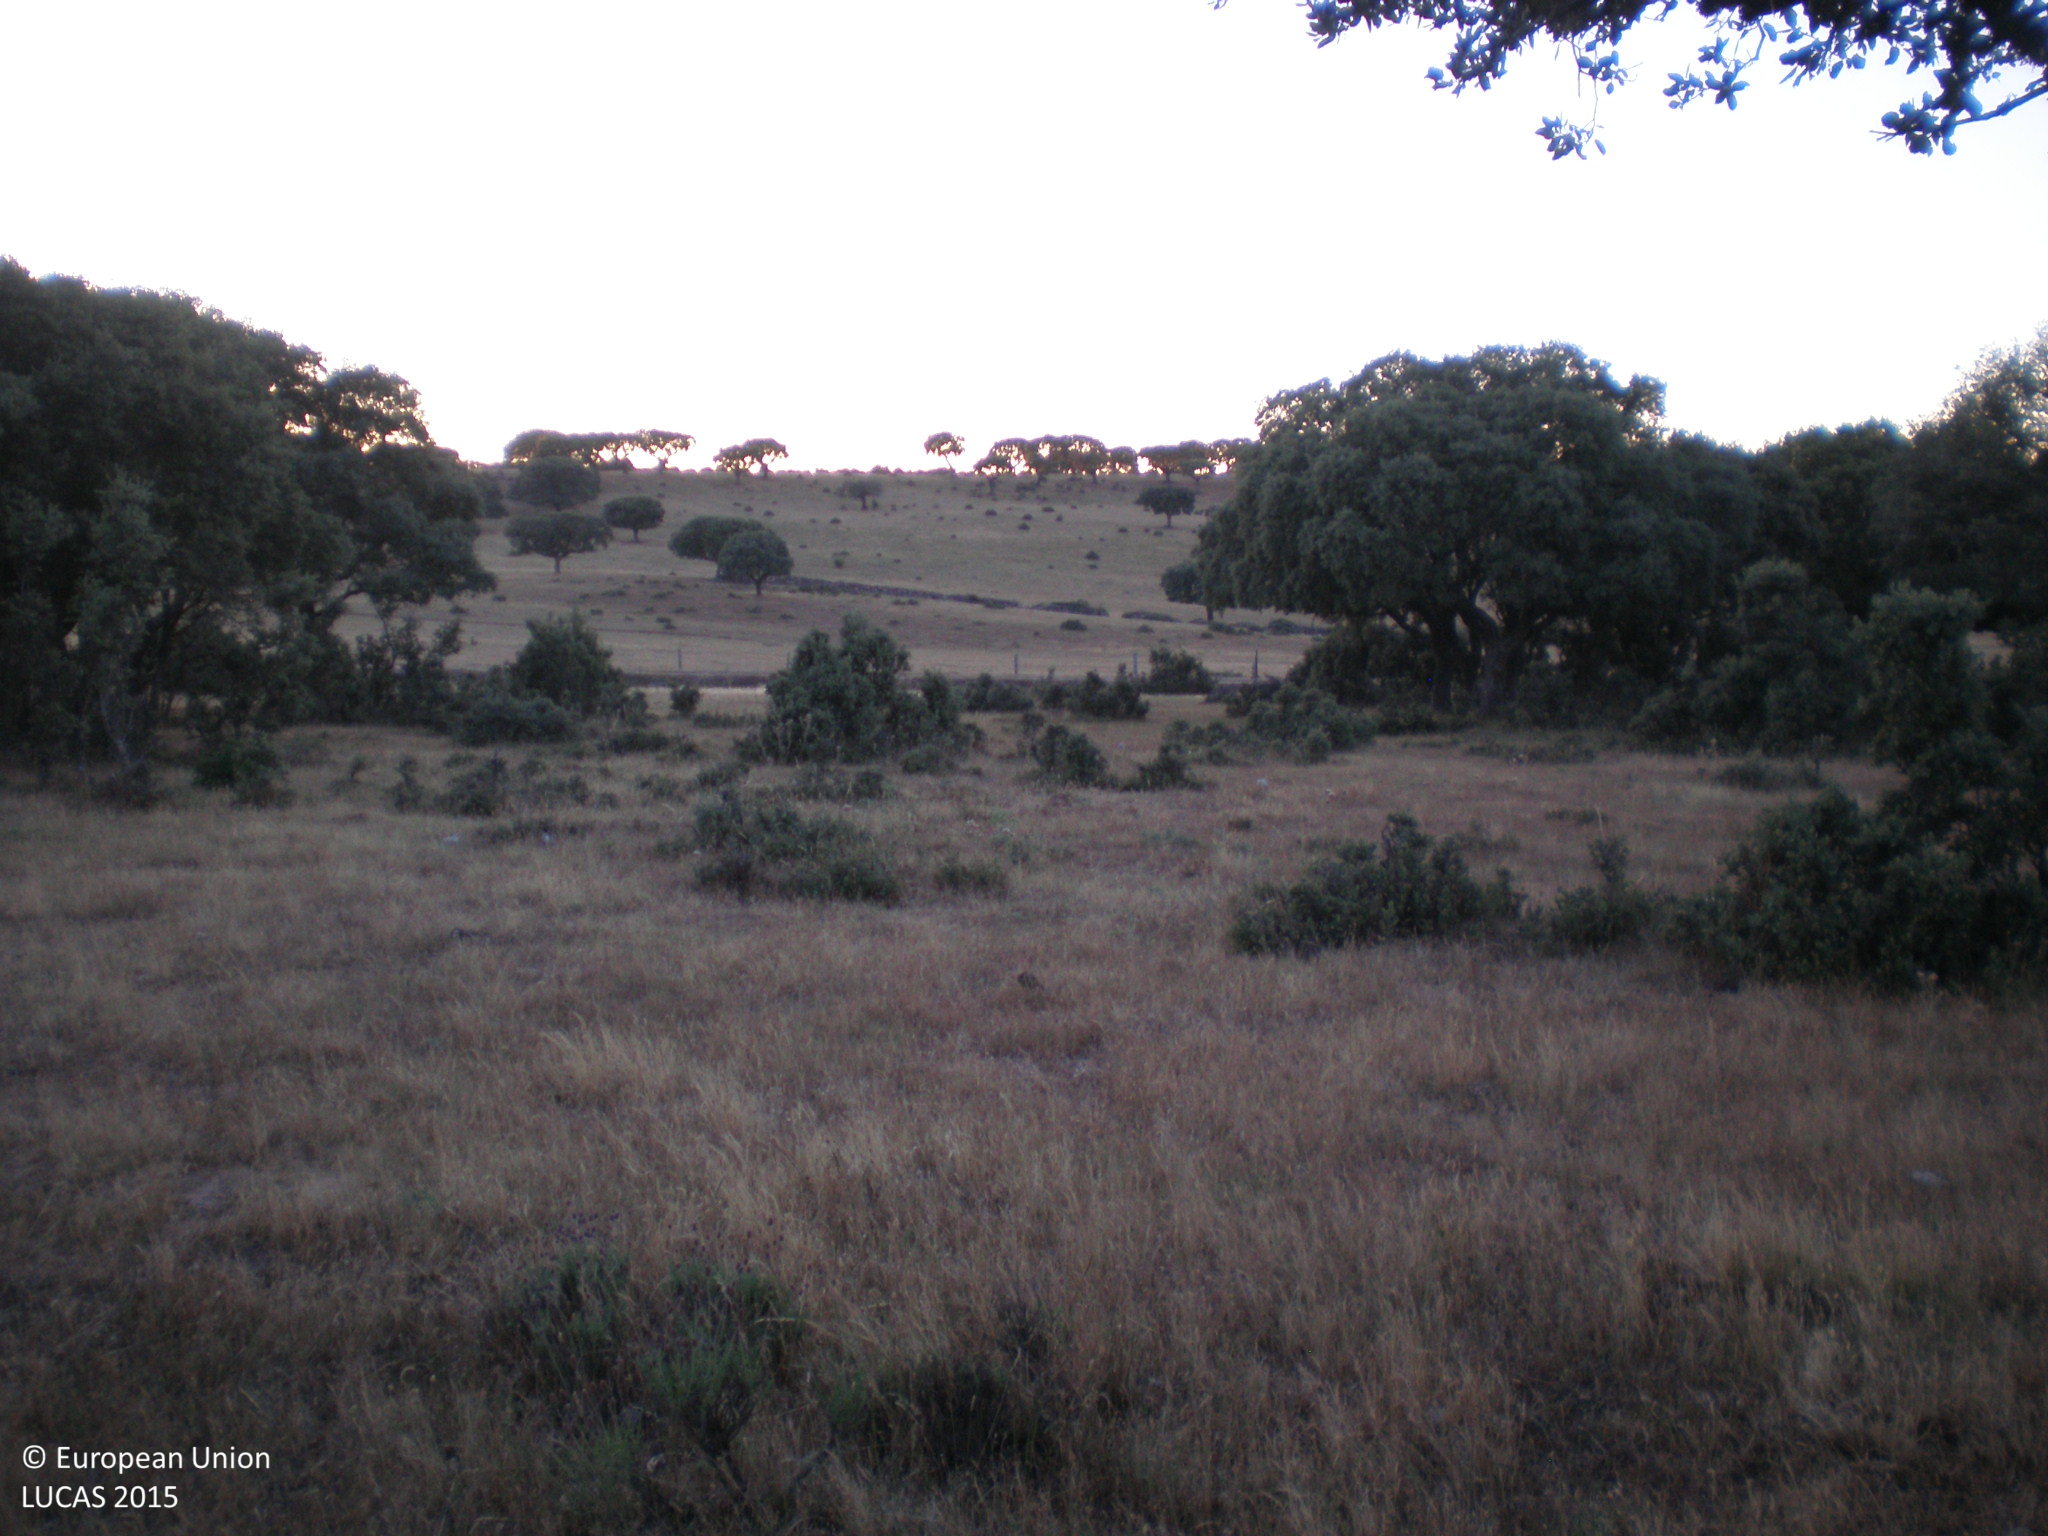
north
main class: Woodland
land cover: Broadleaved woodland
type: broadleaved evergreen forest
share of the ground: 25 - 50 %
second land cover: Grassland without tree/shrub cover
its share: 50 - 75 %
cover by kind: herbaceous plants 70 %, broadleaved forest trees 30 %
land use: Forestry
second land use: Agriculture (excluding fallow land and kitchen gardens)
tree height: < 5 m
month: June
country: ES
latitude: 40.6536
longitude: -5.6724
